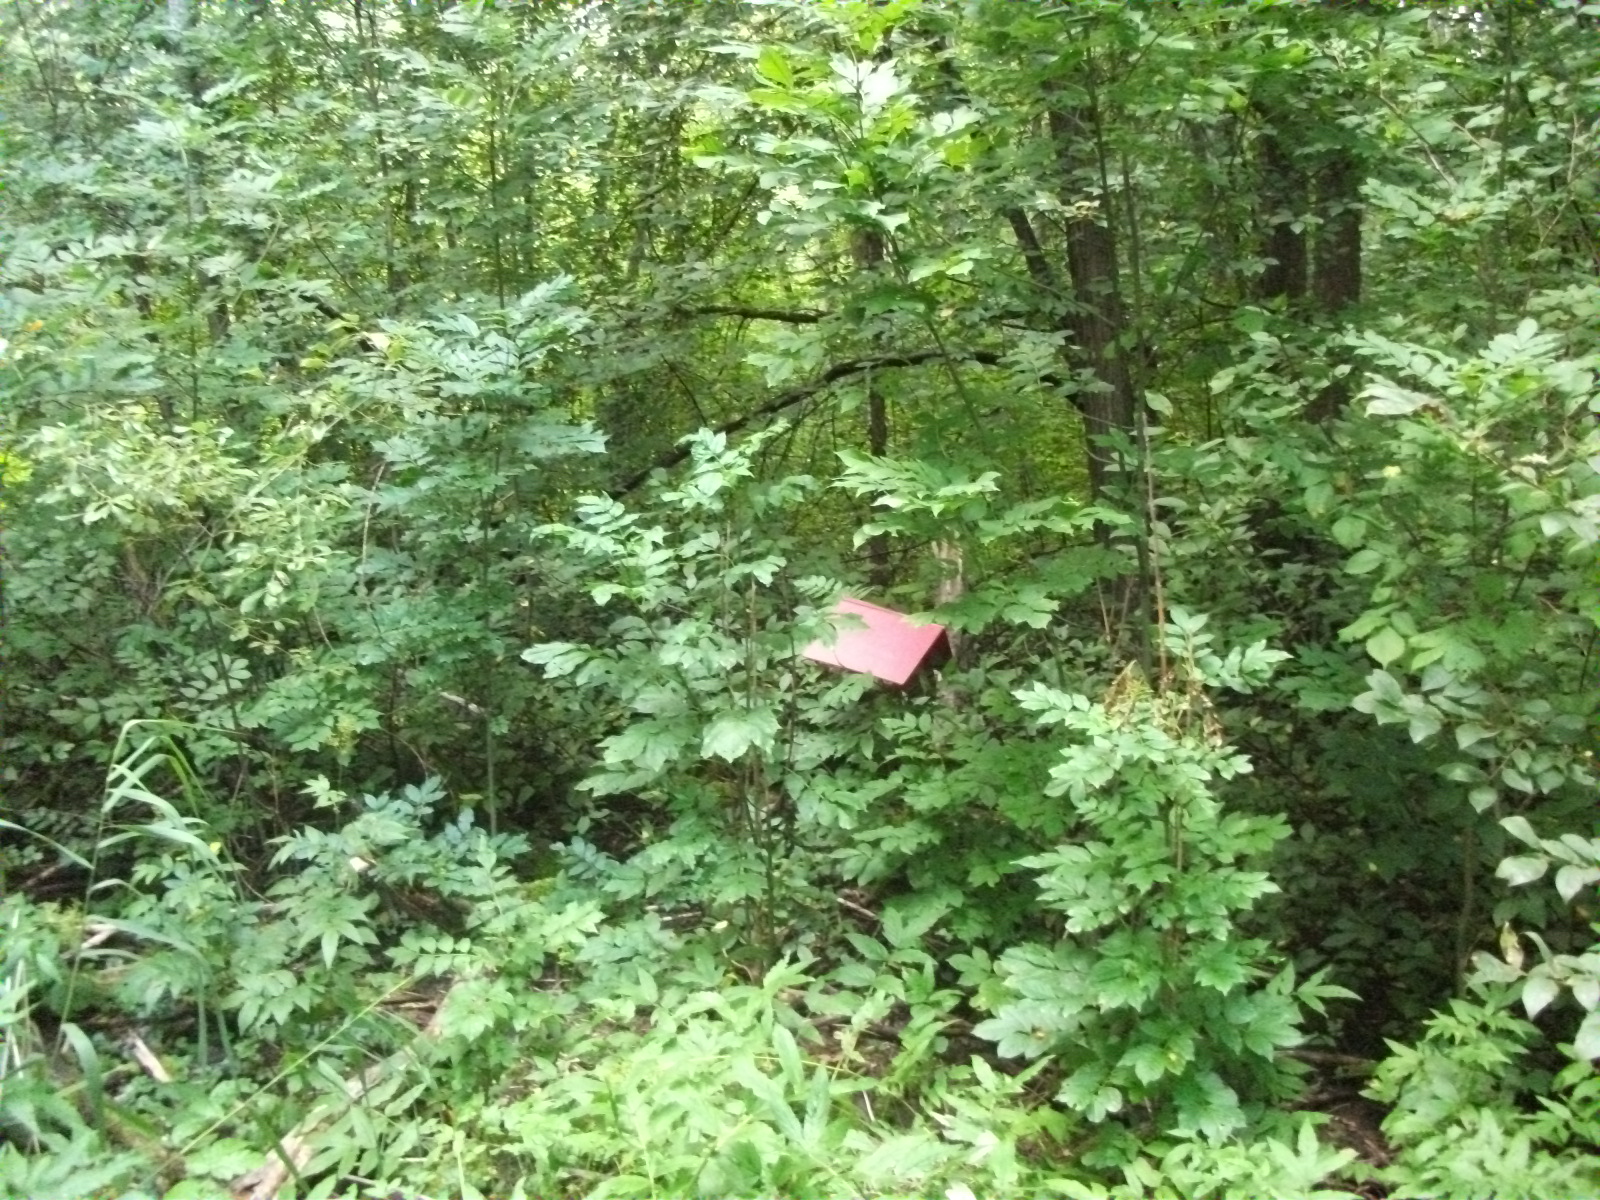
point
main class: Woodland
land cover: Broadleaved woodland
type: non-riverine alder, birch or aspen forest
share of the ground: > 75 %
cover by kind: broadleaved forest trees 85 %, shrubs 10 %, herbaceous plants 5 %
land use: Forestry
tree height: > 5 m
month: August
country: LV
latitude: 56.7579
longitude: 26.5538
